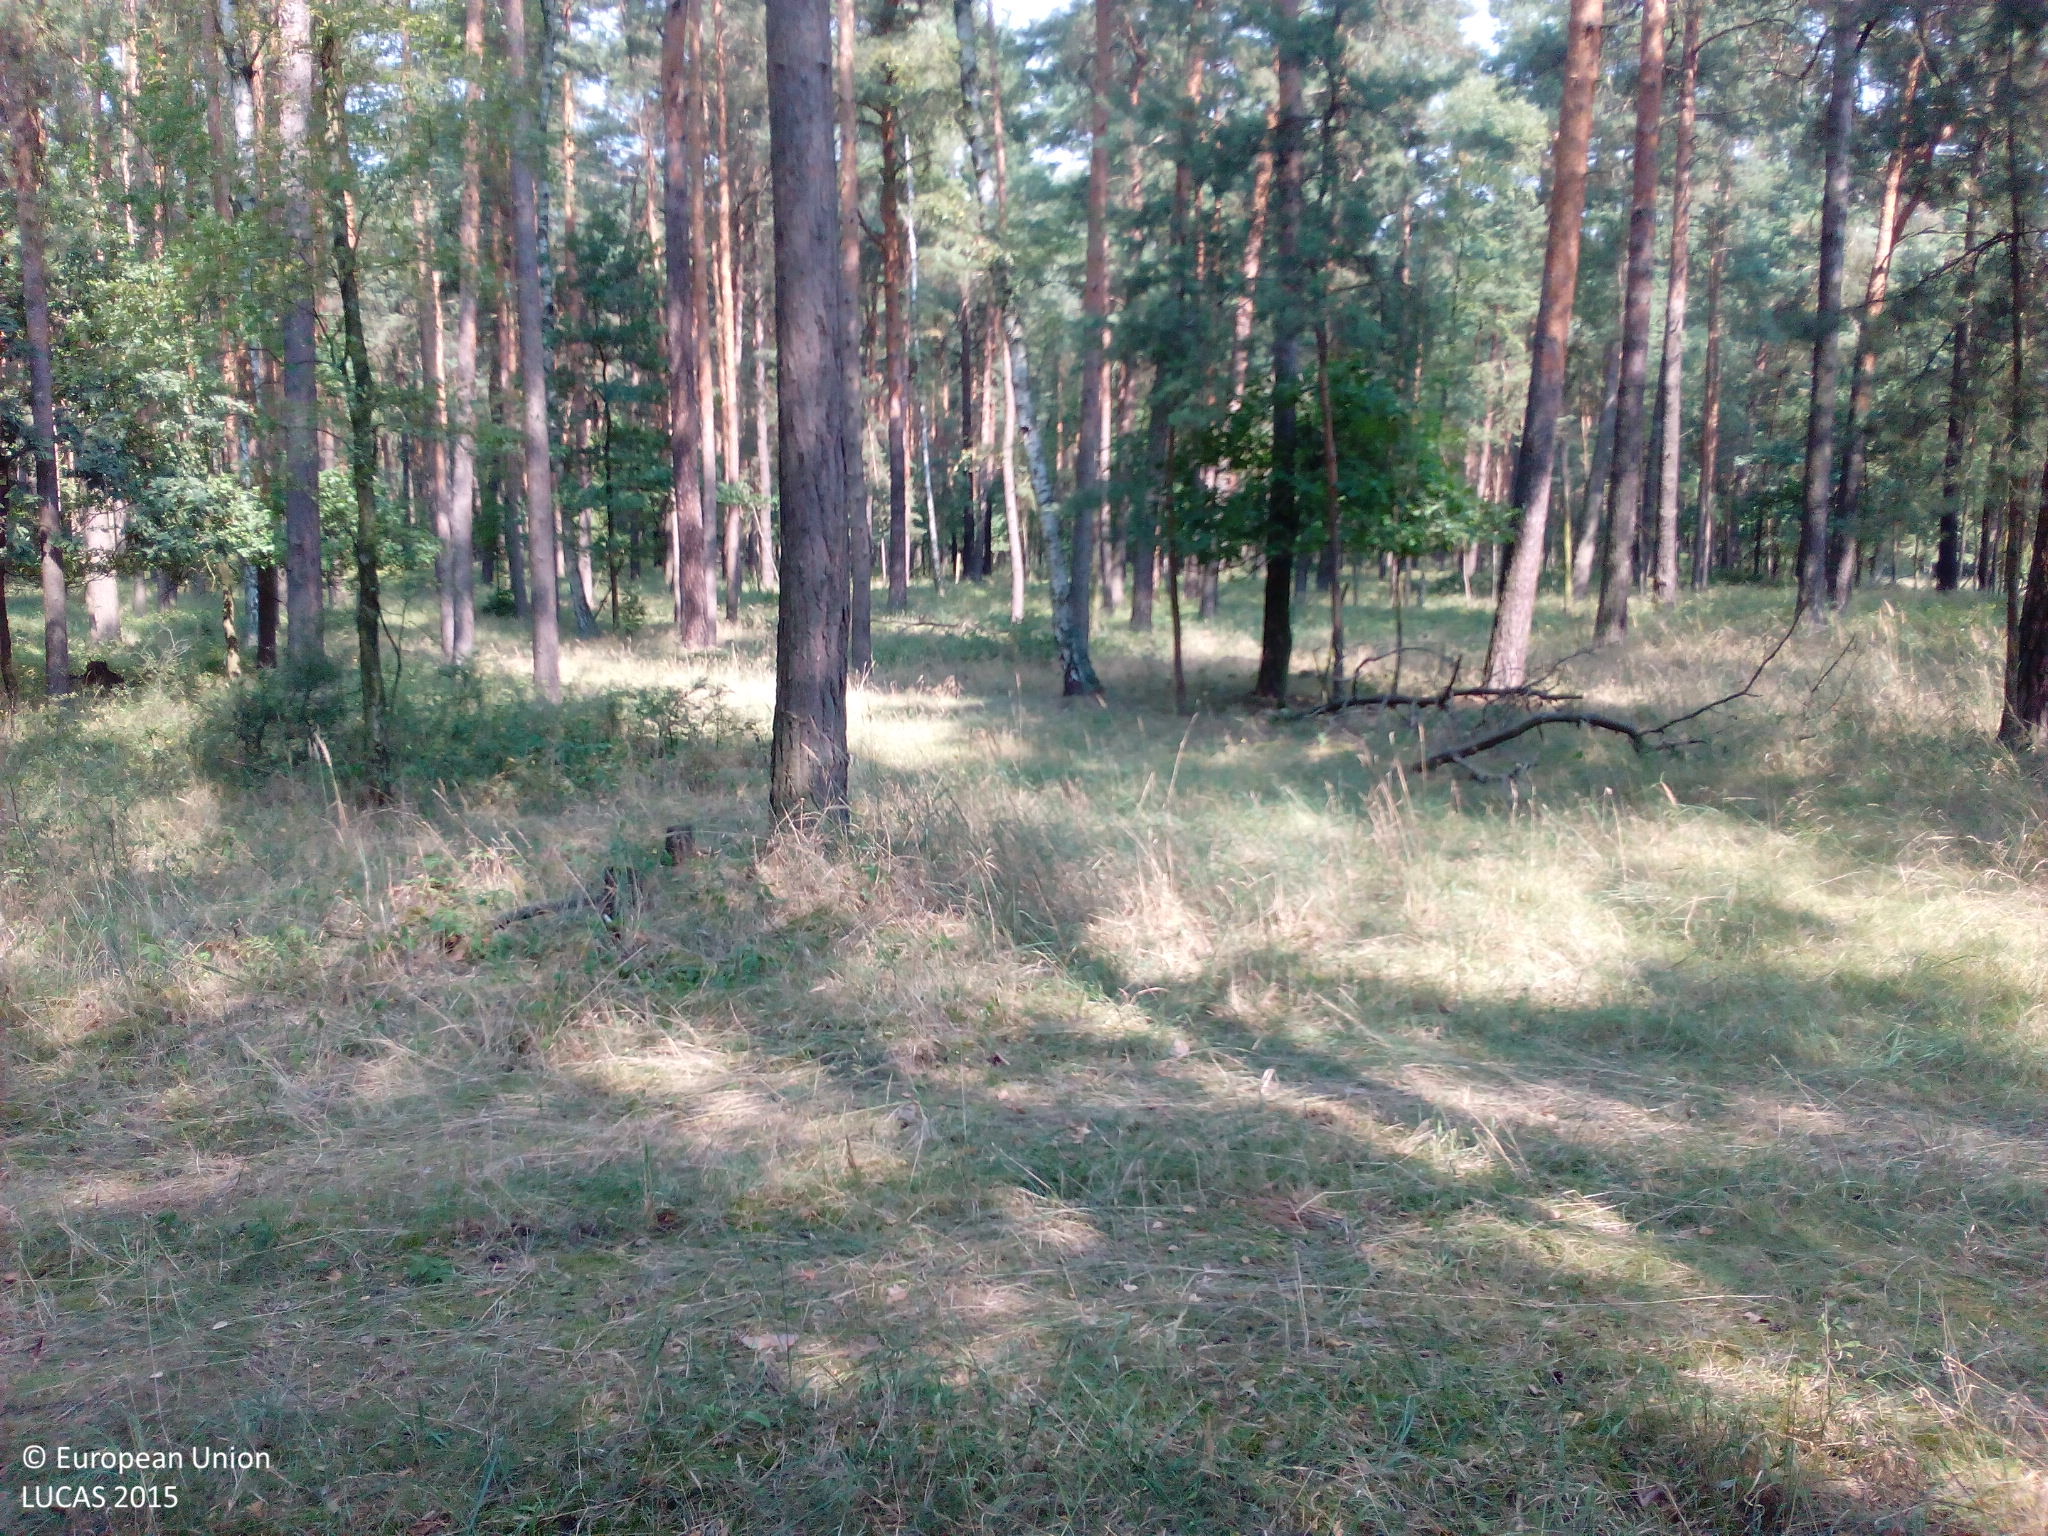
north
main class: Woodland
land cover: Pine dominated coniferous woodland
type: hemiboreal forest and nemoral coniferous forest and mixed broadleaved-coniferous forest
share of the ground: > 75 %
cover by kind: coniferous forest trees 95 %, herbaceous plants 5 %
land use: Forestry
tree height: > 5 m
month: August
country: DE
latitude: 51.7563
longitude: 12.5640
